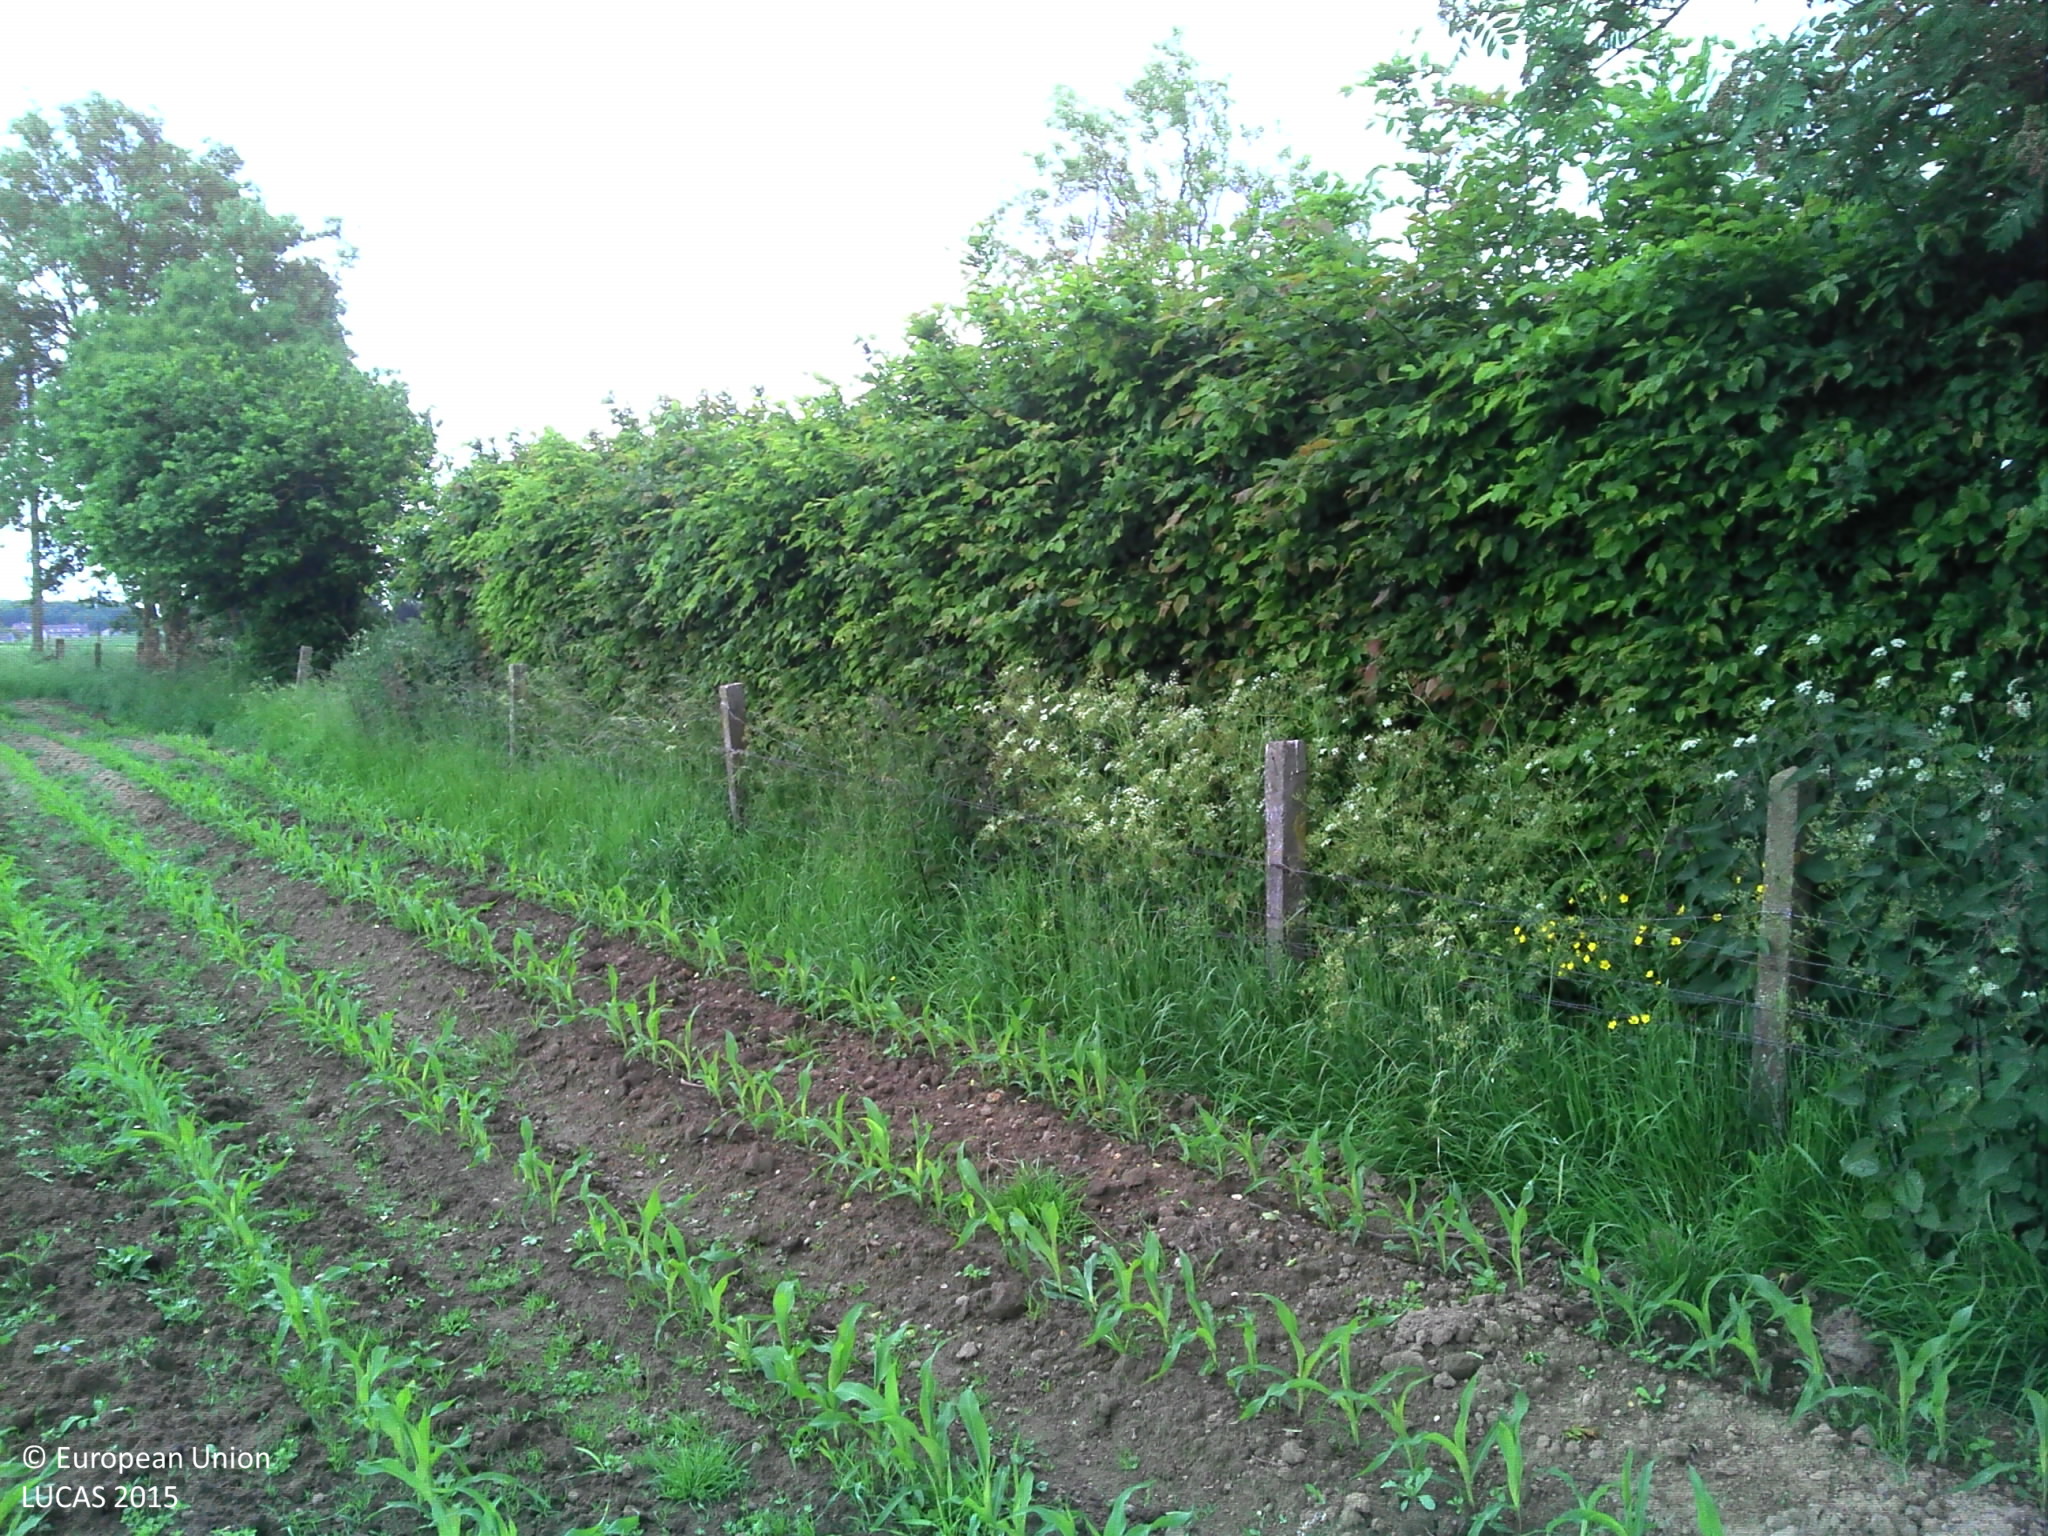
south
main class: Cropland
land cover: Maize
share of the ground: < 10 %
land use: Agriculture (excluding fallow land and kitchen gardens)
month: June
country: BE
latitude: 50.8256
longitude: 3.4474
